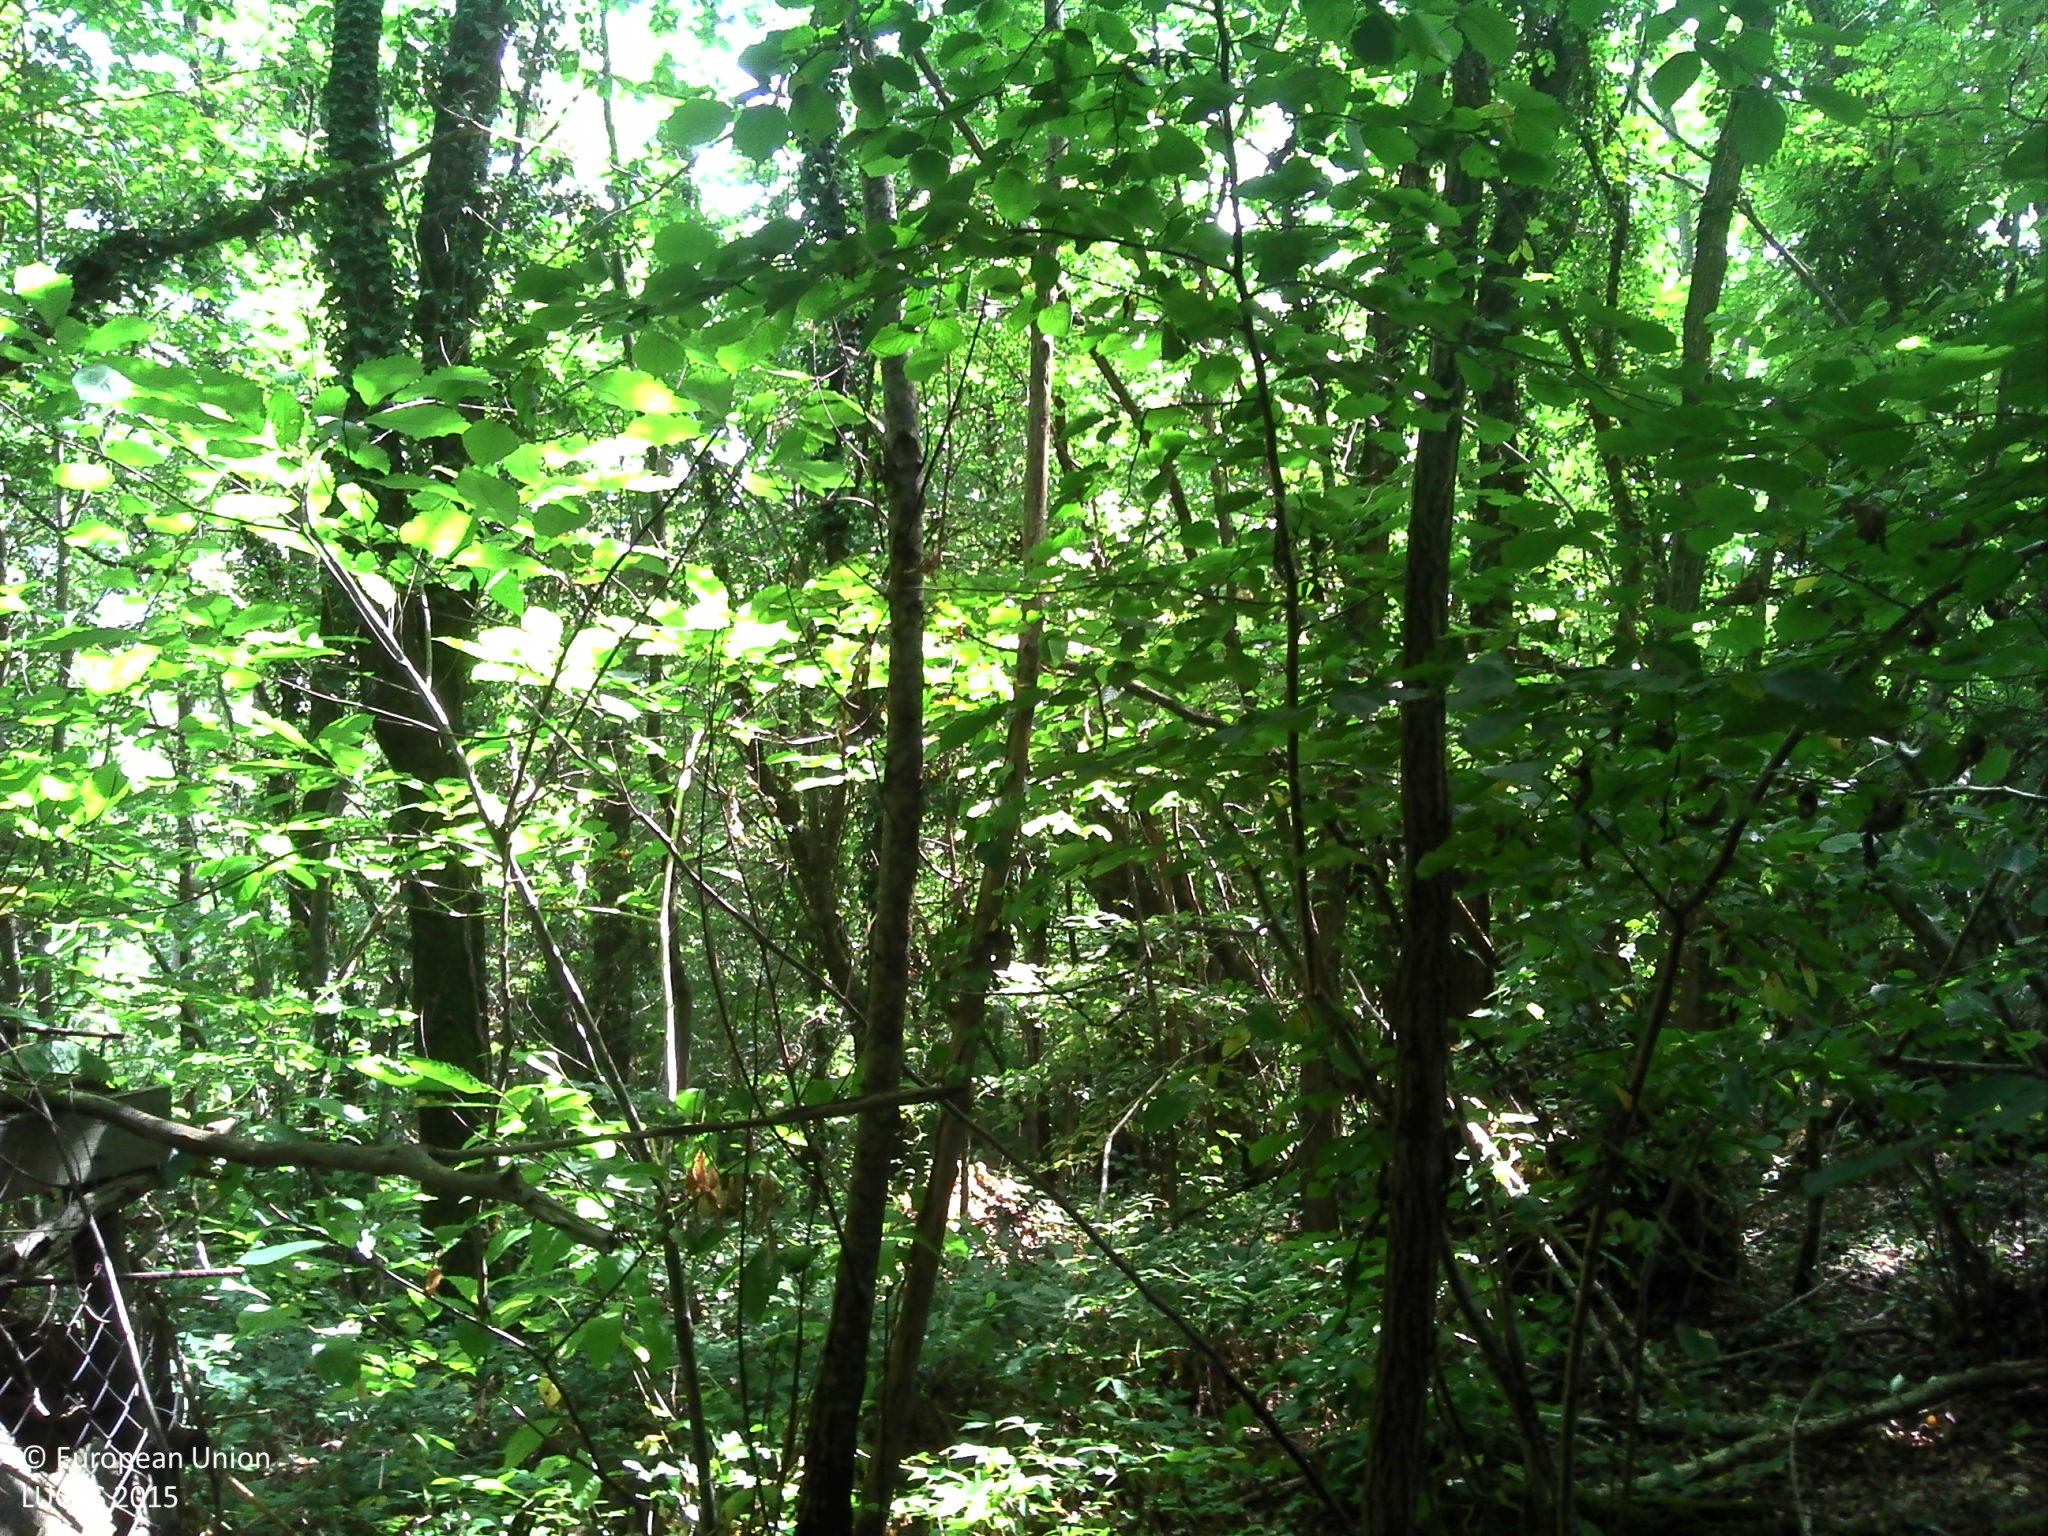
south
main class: Woodland
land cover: Broadleaved woodland
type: mesophytic deciduous forest
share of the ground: > 75 %
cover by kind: broadleaved forest trees 70 %, herbaceous plants 15 %, shrubs 10 %
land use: Forestry
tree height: > 5 m
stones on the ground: < 10 %
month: August
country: FR
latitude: 45.2072
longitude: 0.7597
